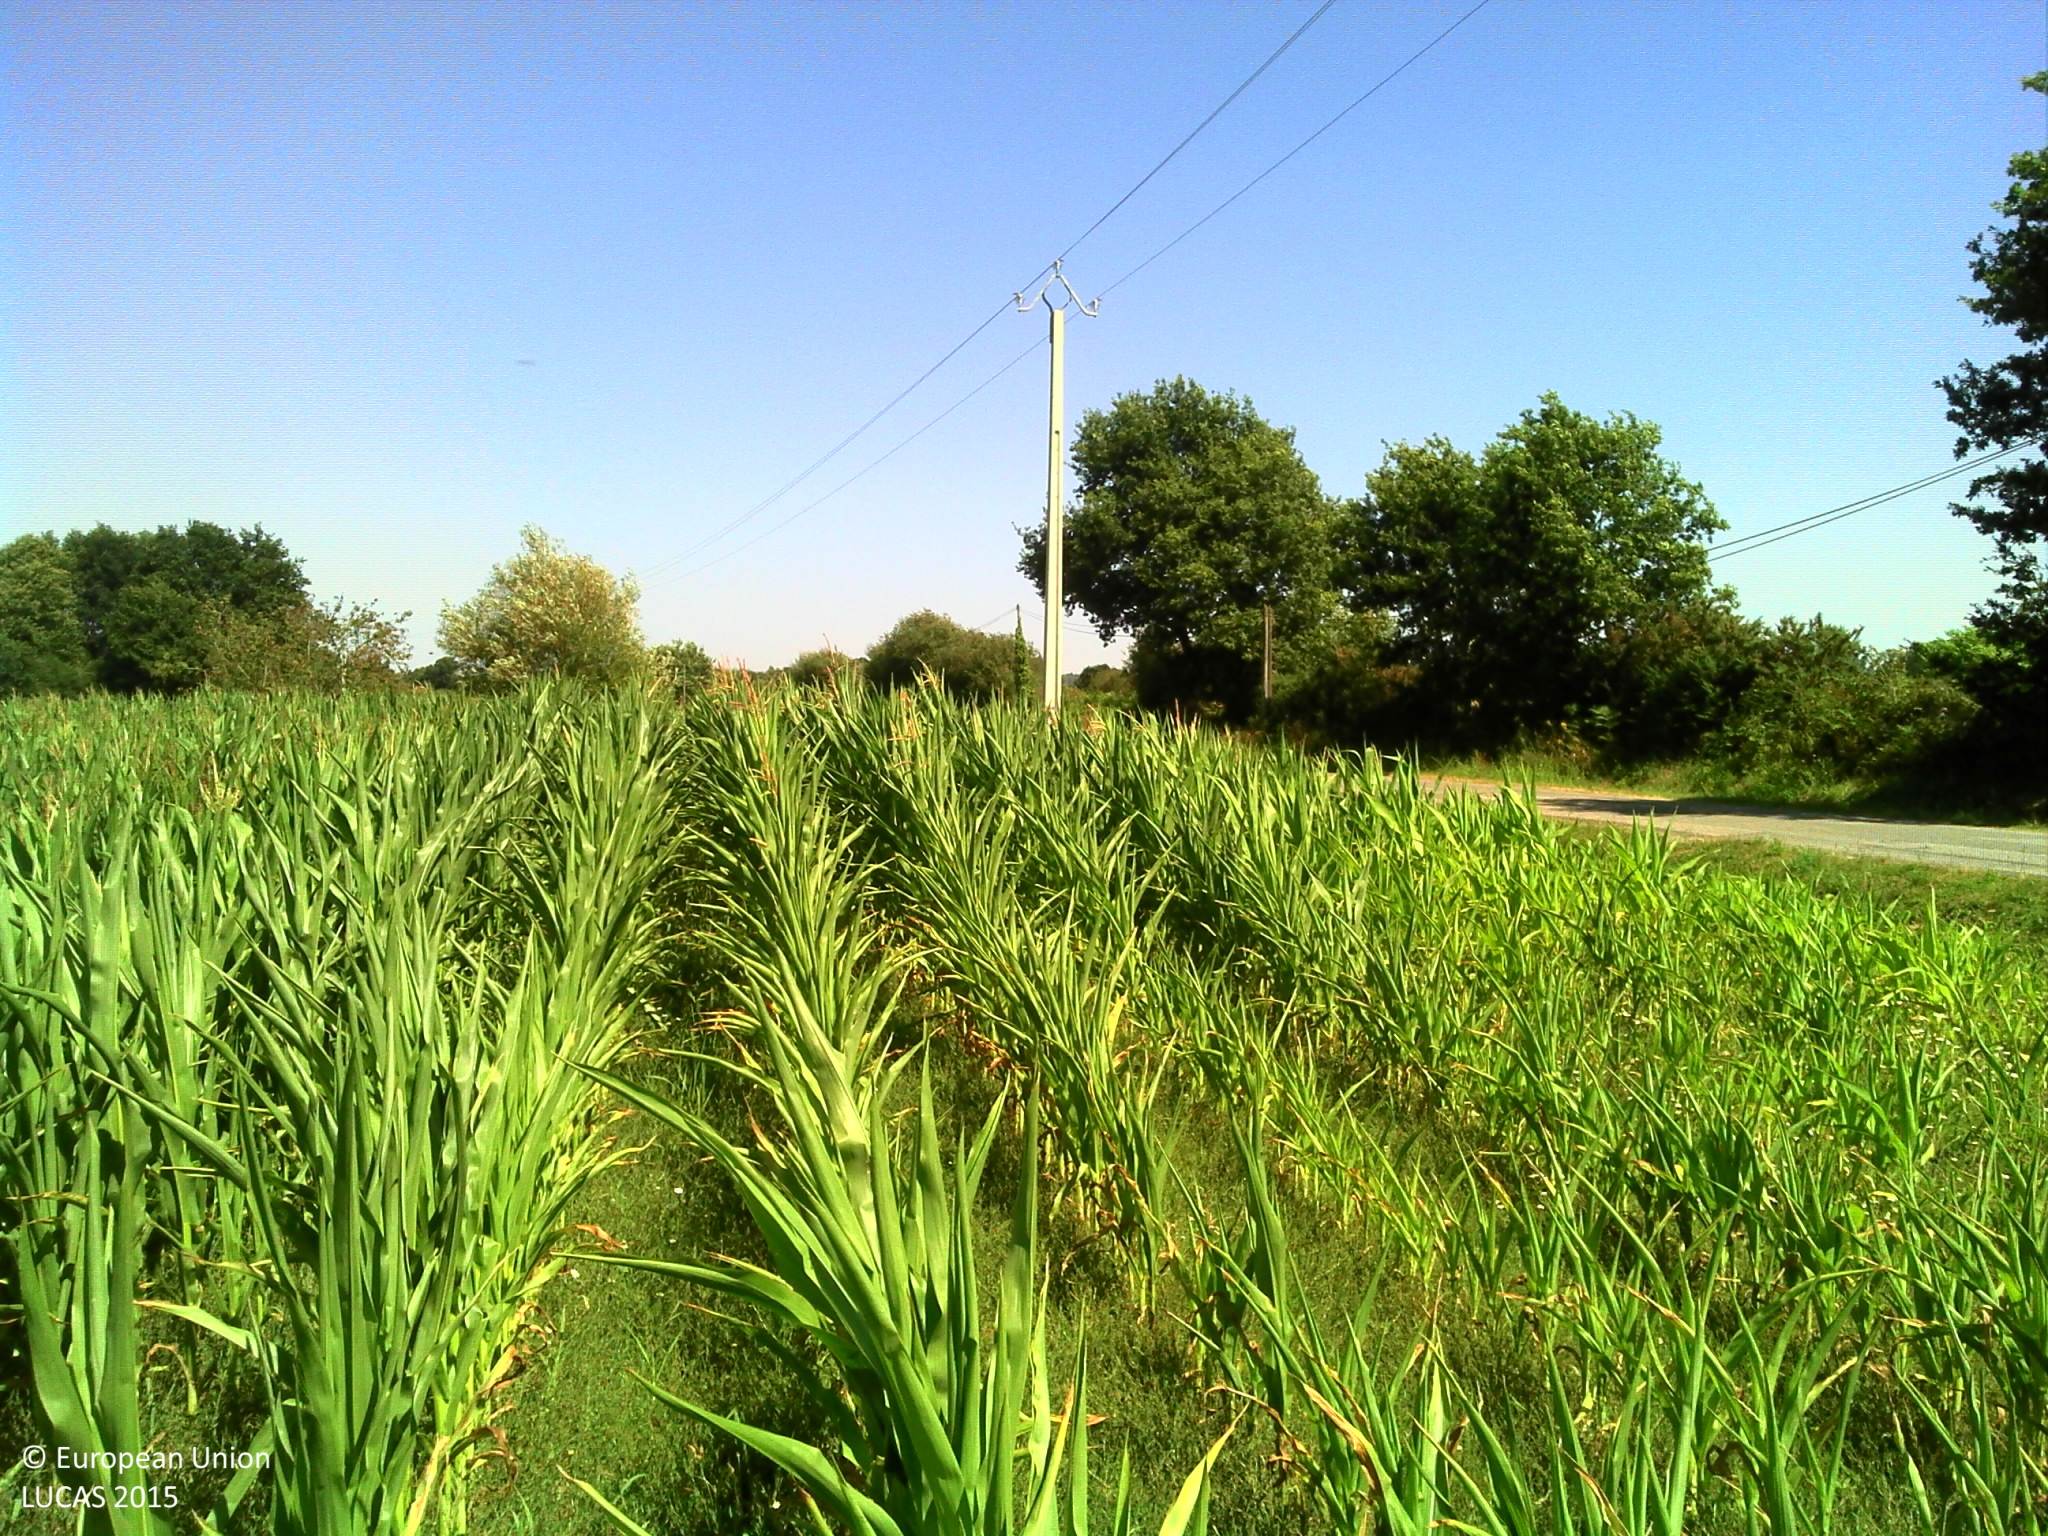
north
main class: Cropland
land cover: Maize
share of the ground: 50 - 75 %
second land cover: Spontaneously vegetated surfaces
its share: 10 - 25 %
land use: Agriculture (excluding fallow land and kitchen gardens)
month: July
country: FR
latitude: 47.7127
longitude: -1.8176
